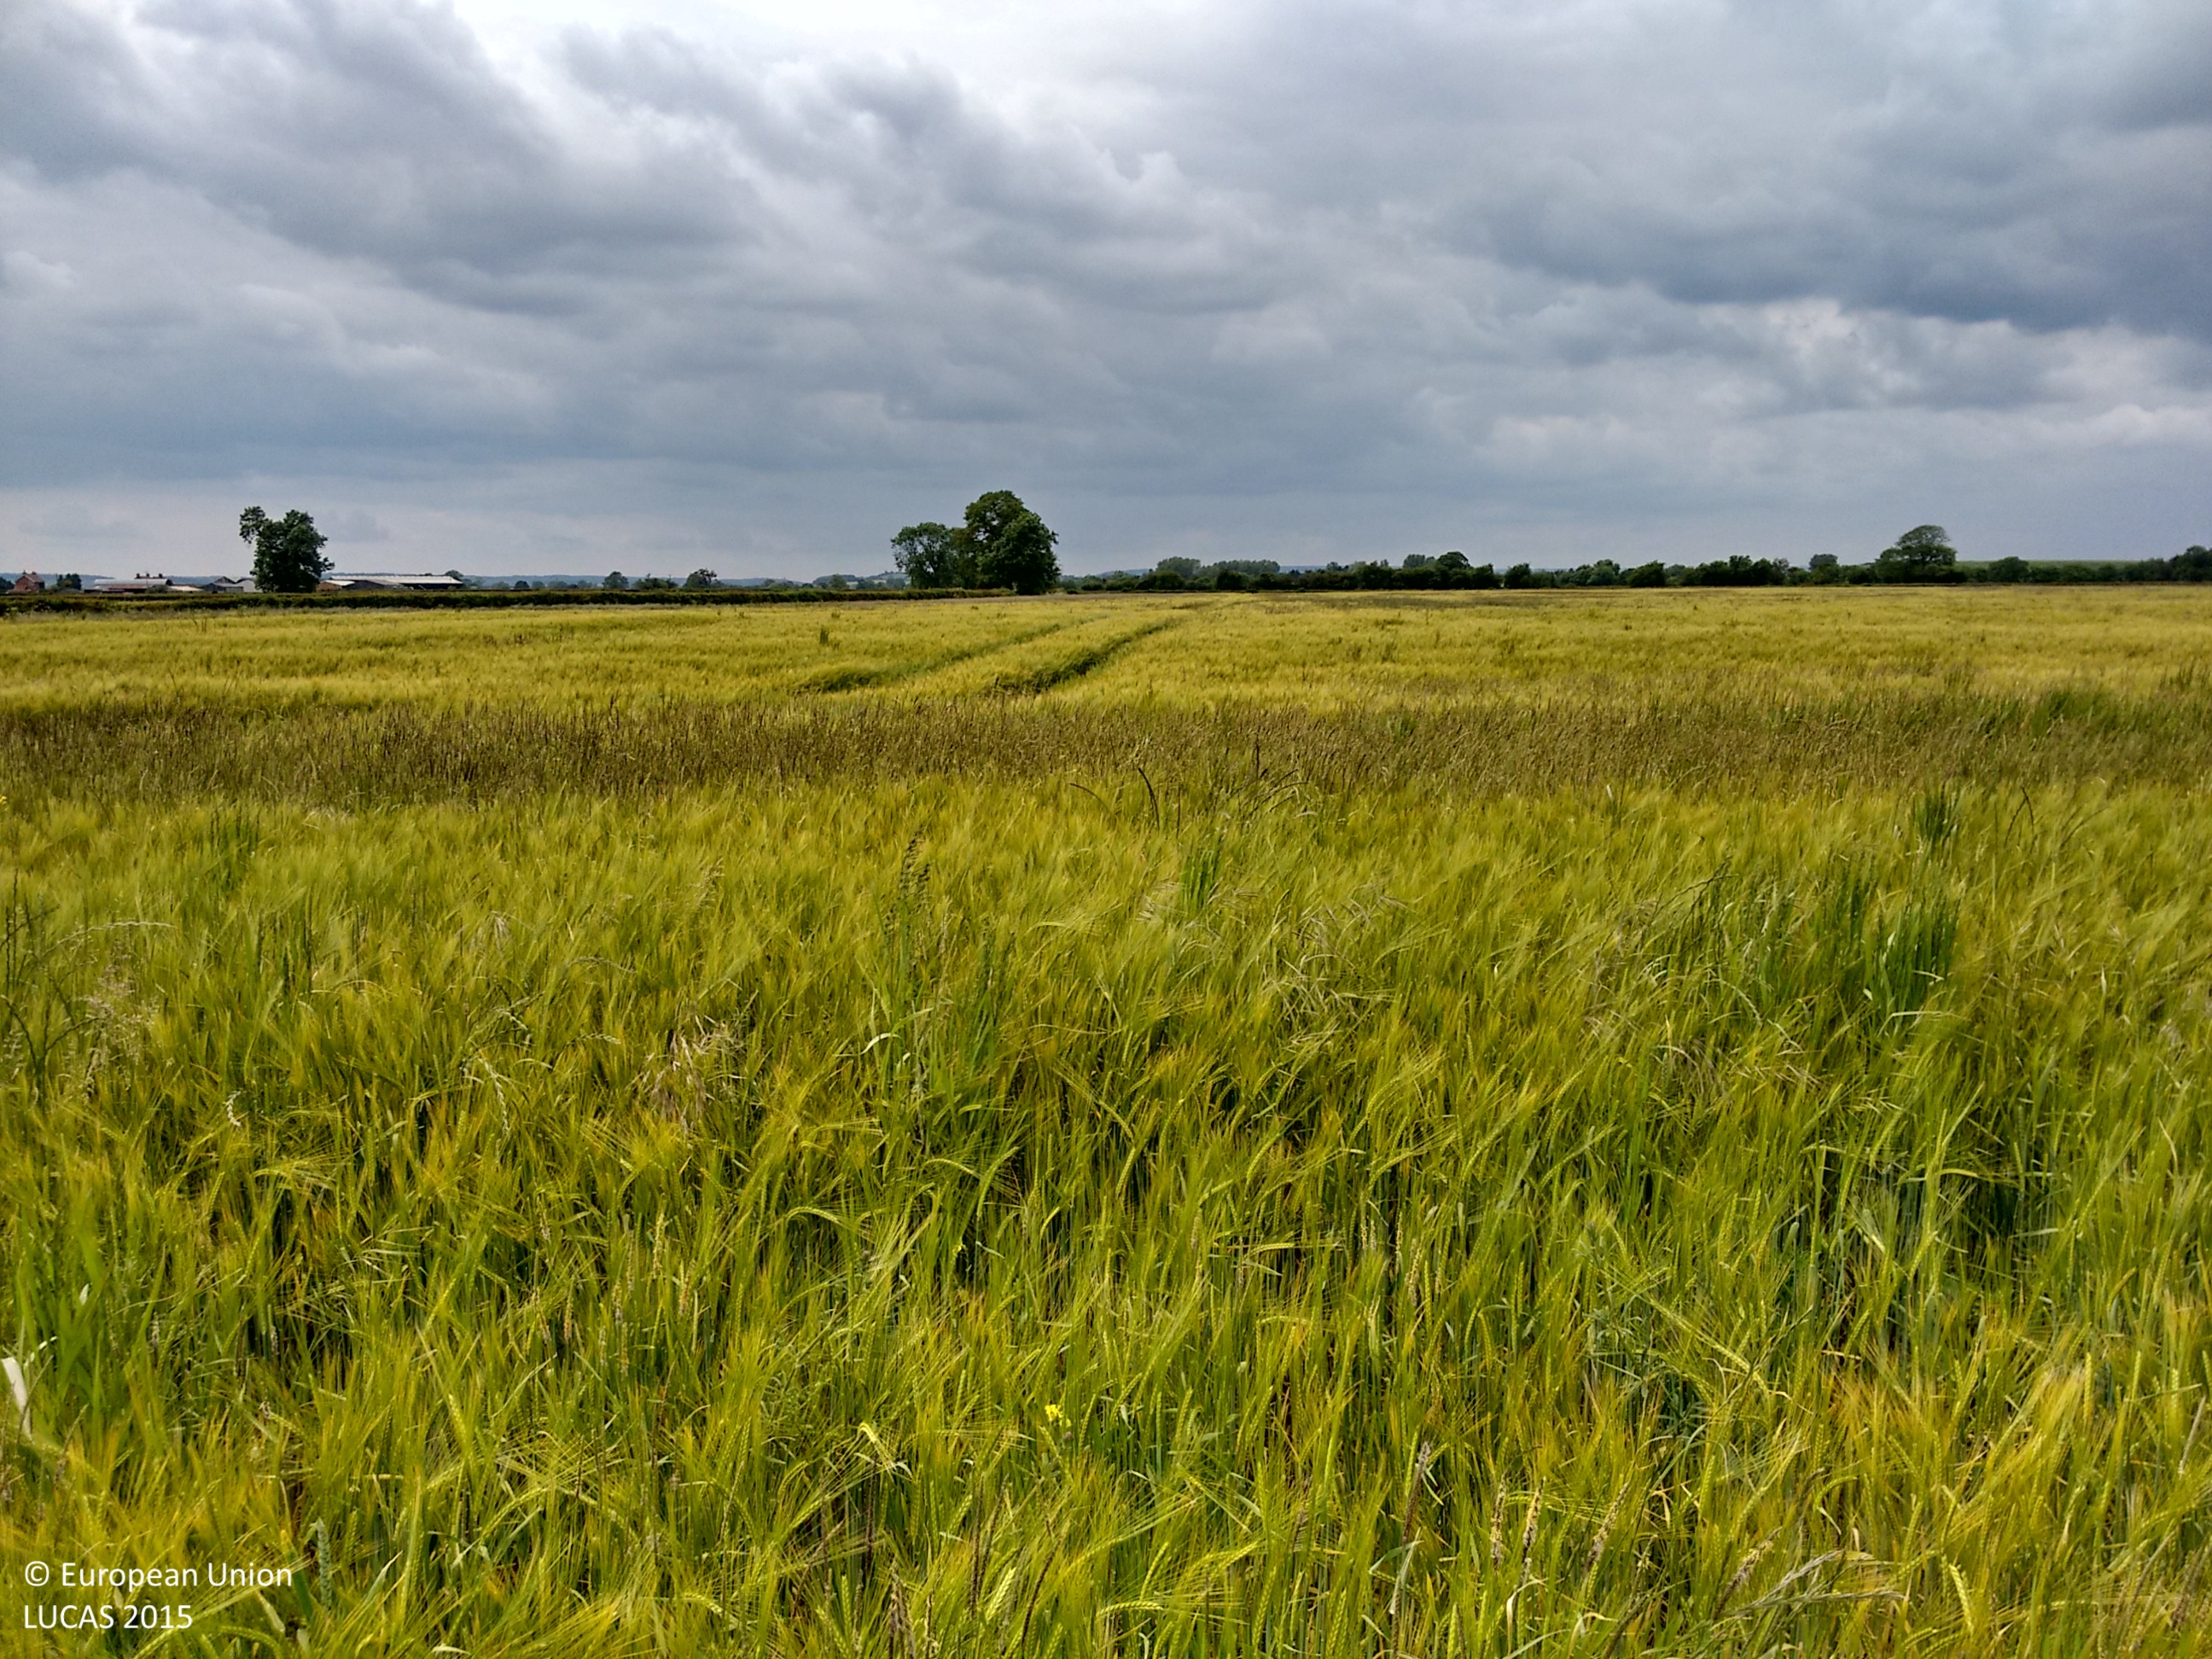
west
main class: Cropland
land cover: Barley
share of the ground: > 75 %
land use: Agriculture (excluding fallow land and kitchen gardens)
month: June
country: GB
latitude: 54.1989
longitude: -0.8783
